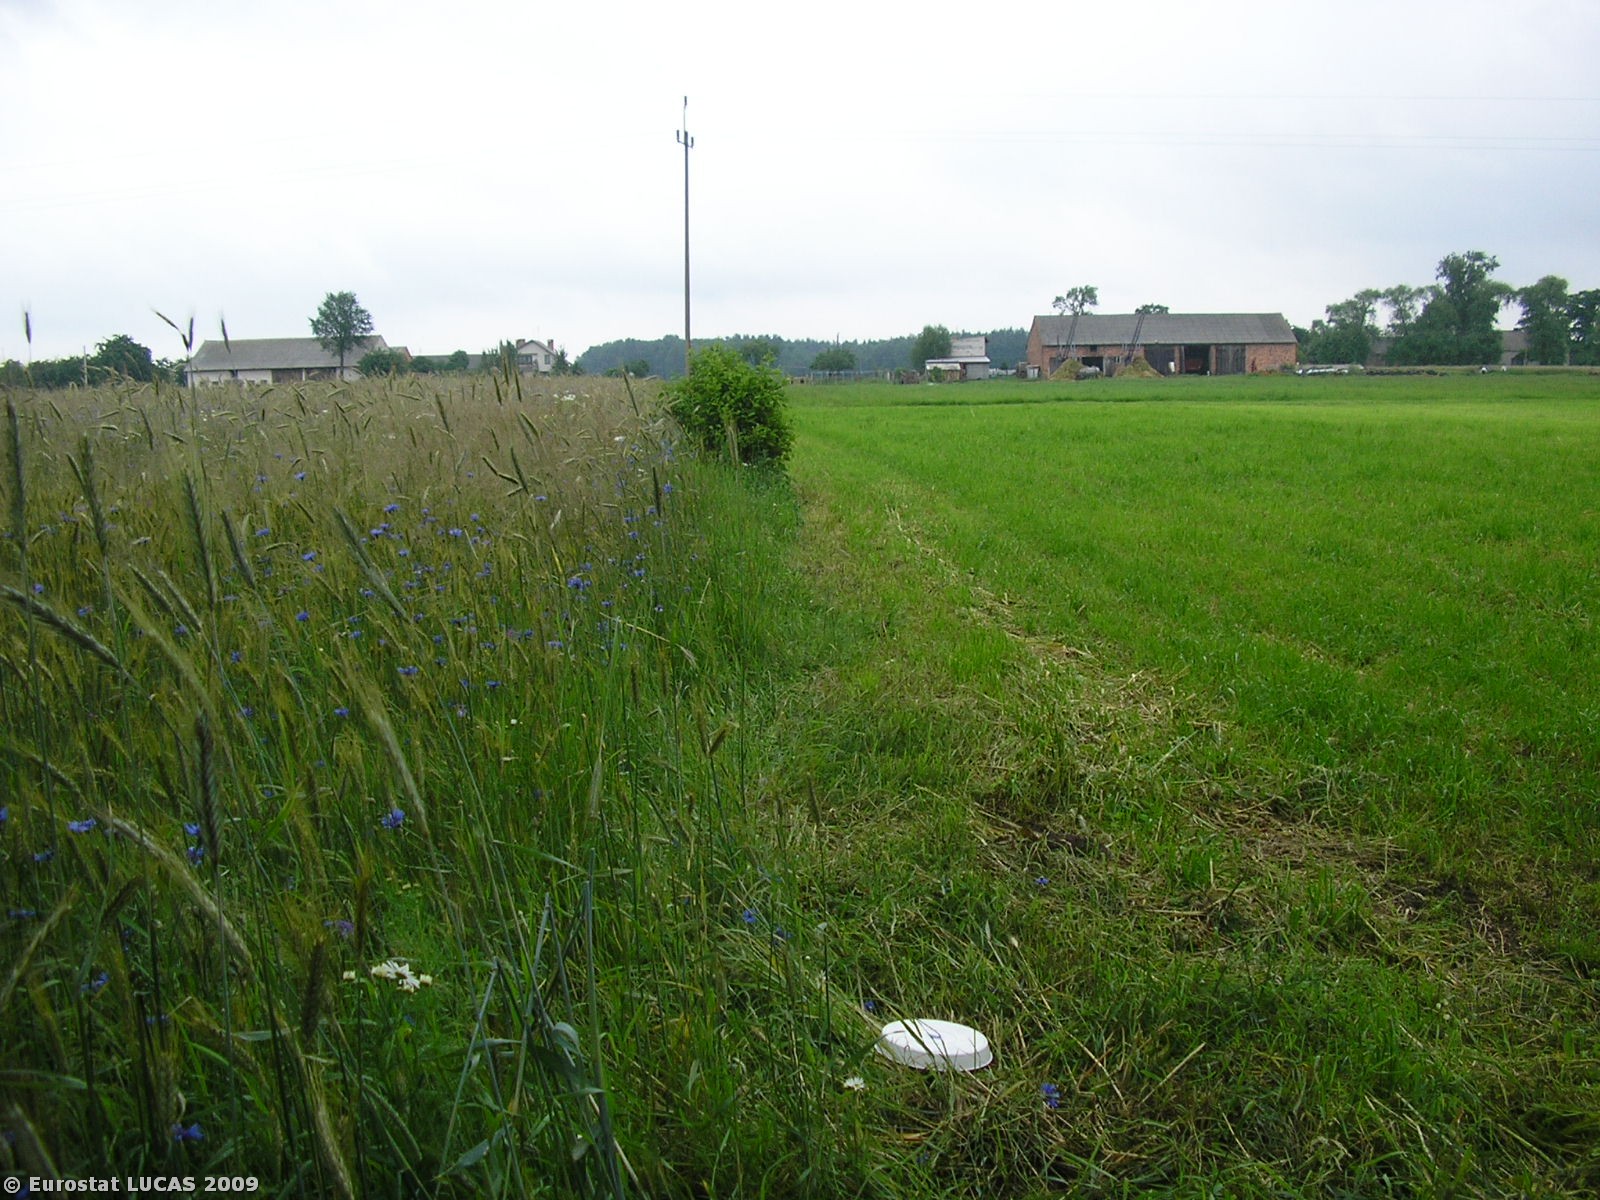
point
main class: Grassland
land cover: Grassland without tree/shrub cover
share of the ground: > 75 %
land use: Agriculture (excluding fallow land and kitchen gardens)
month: June
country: PL
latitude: 51.3529
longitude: 18.4479
